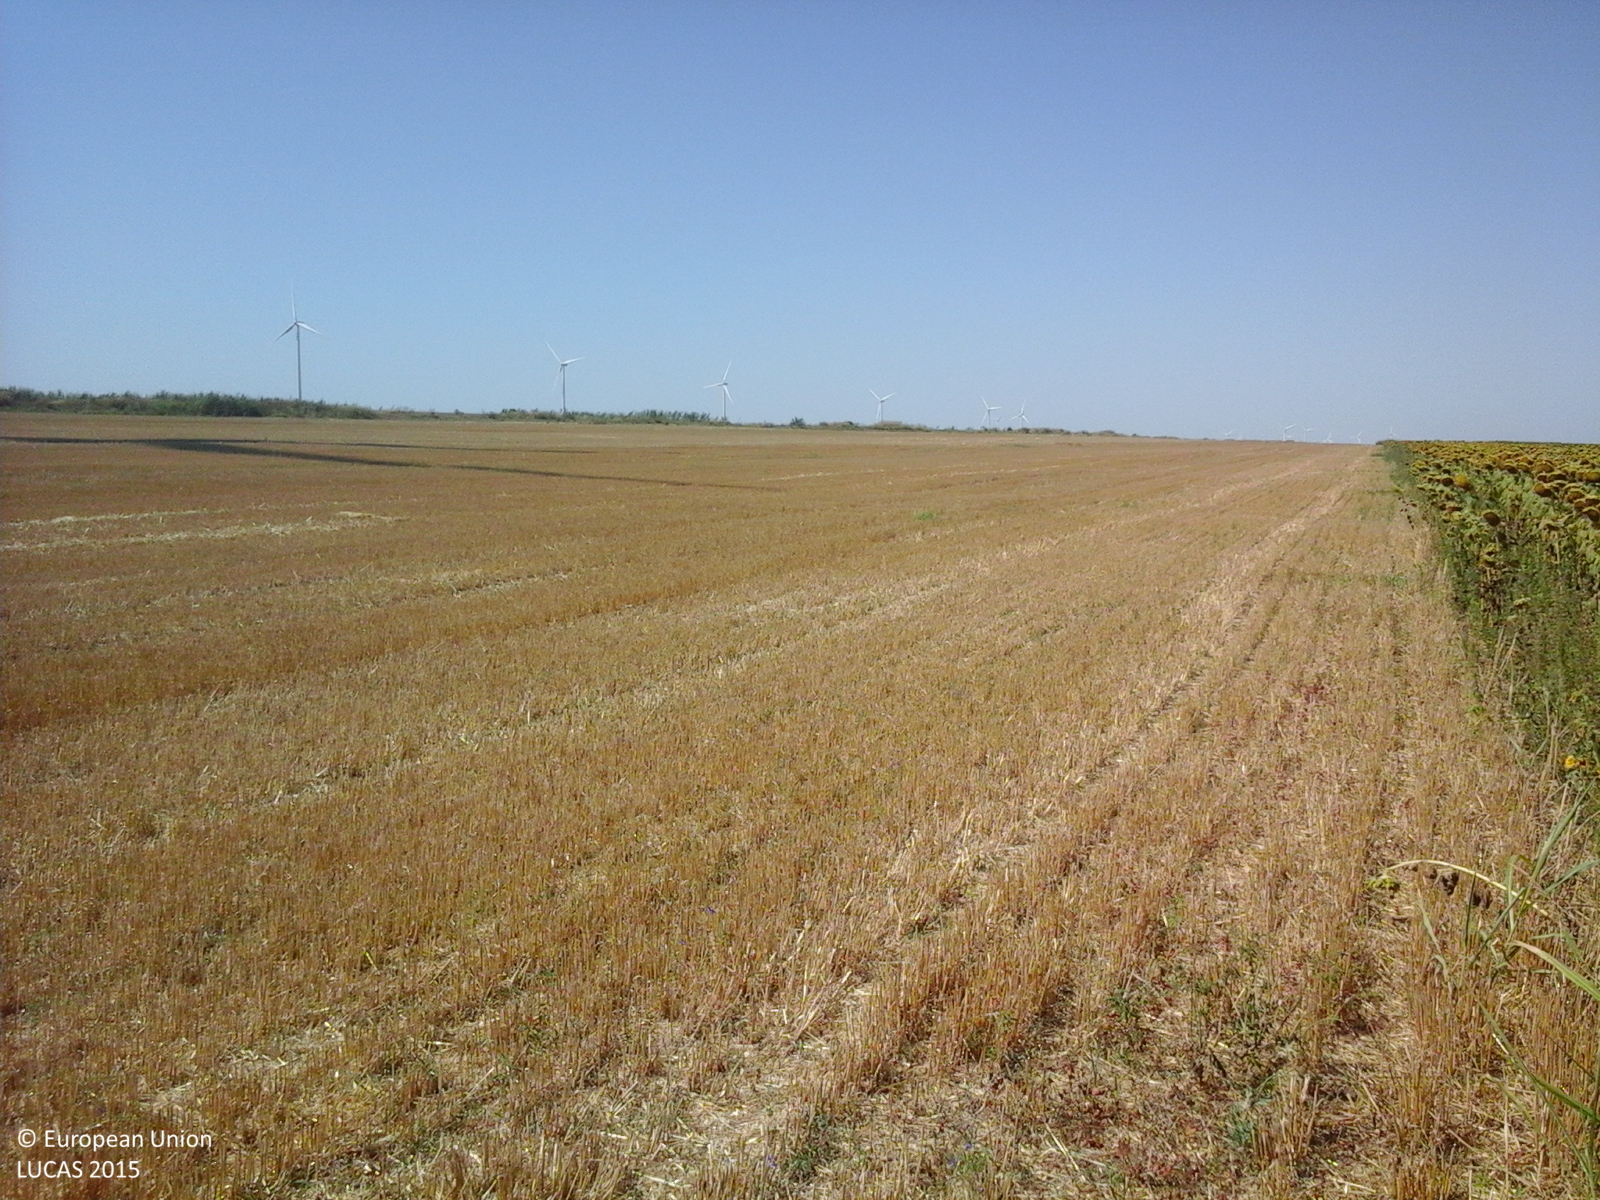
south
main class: Cropland
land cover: Sunflower
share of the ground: > 75 %
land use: Agriculture (excluding fallow land and kitchen gardens)
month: August
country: RO
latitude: 44.4286
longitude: 28.2667
